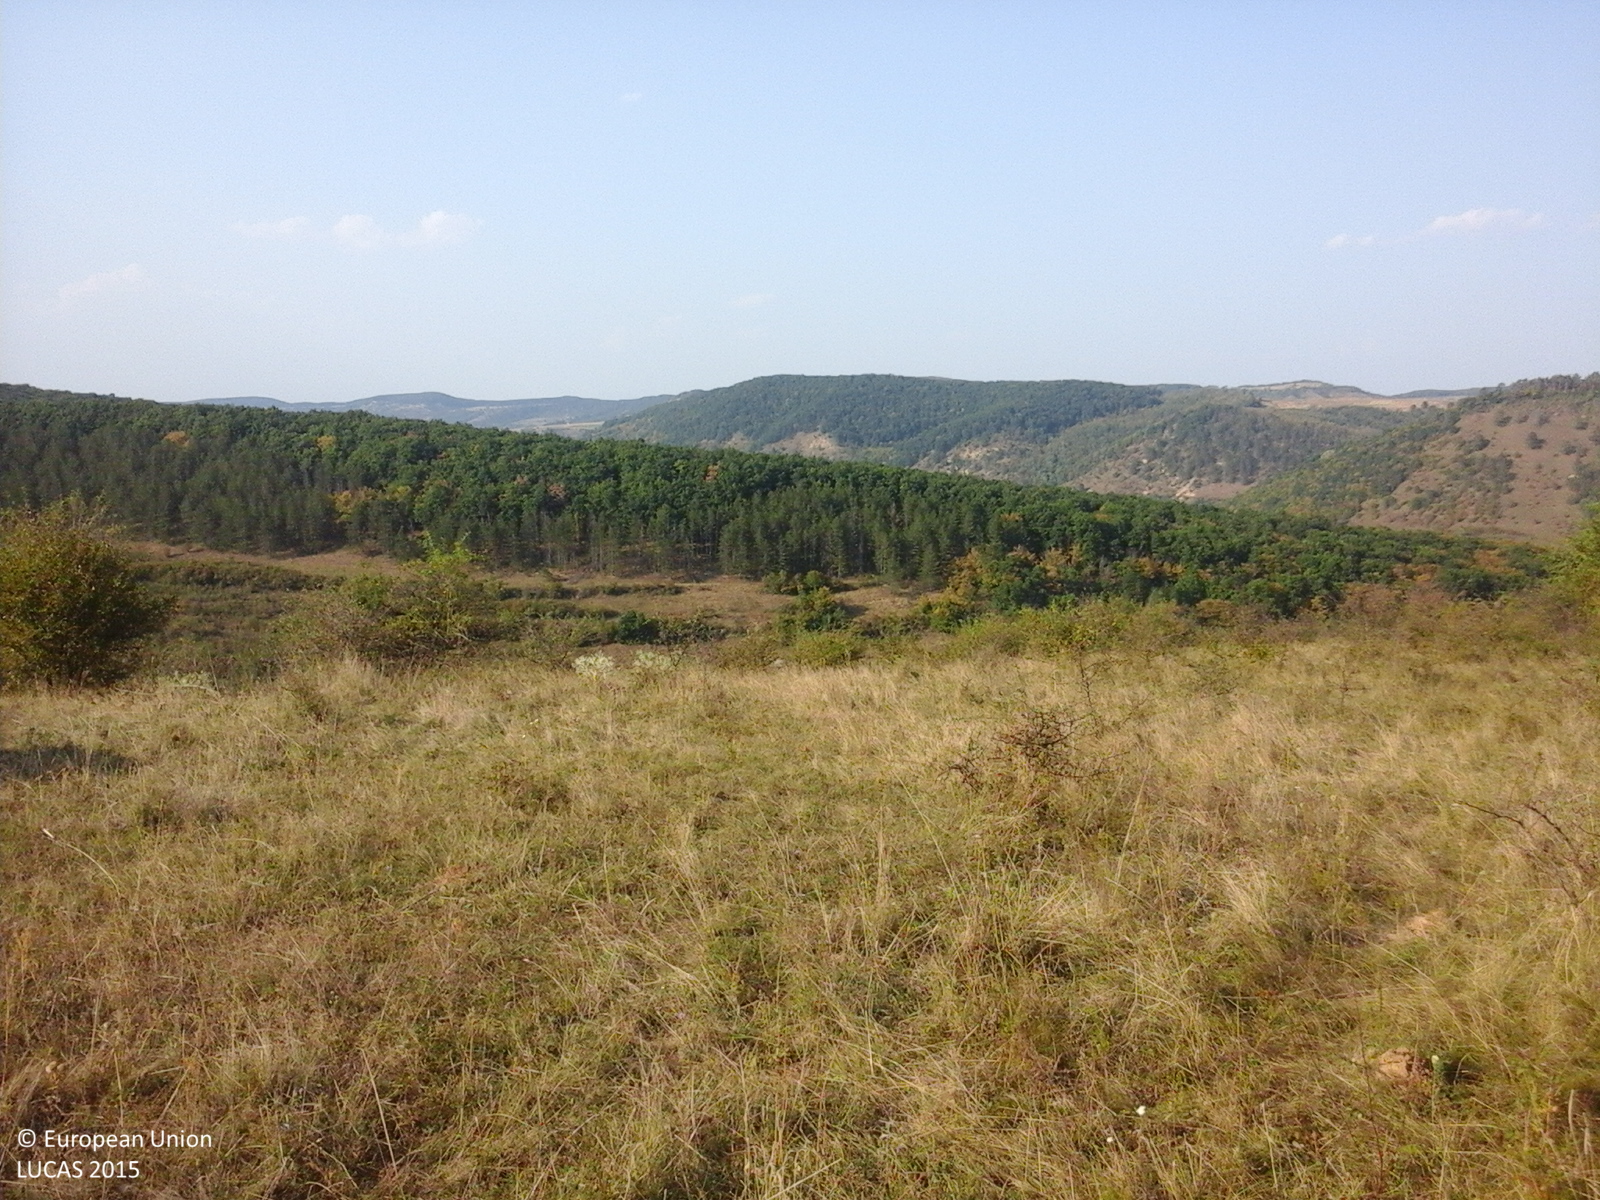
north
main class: Grassland
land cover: Grassland with sparse tree/shrub cover
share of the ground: > 75 %
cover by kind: herbaceous plants 85 %, shrubs 10 %, broadleaved forest trees 5 %
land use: Agriculture (excluding fallow land and kitchen gardens)
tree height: < 5 m
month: September
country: RO
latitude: 47.0594
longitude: 24.2115
